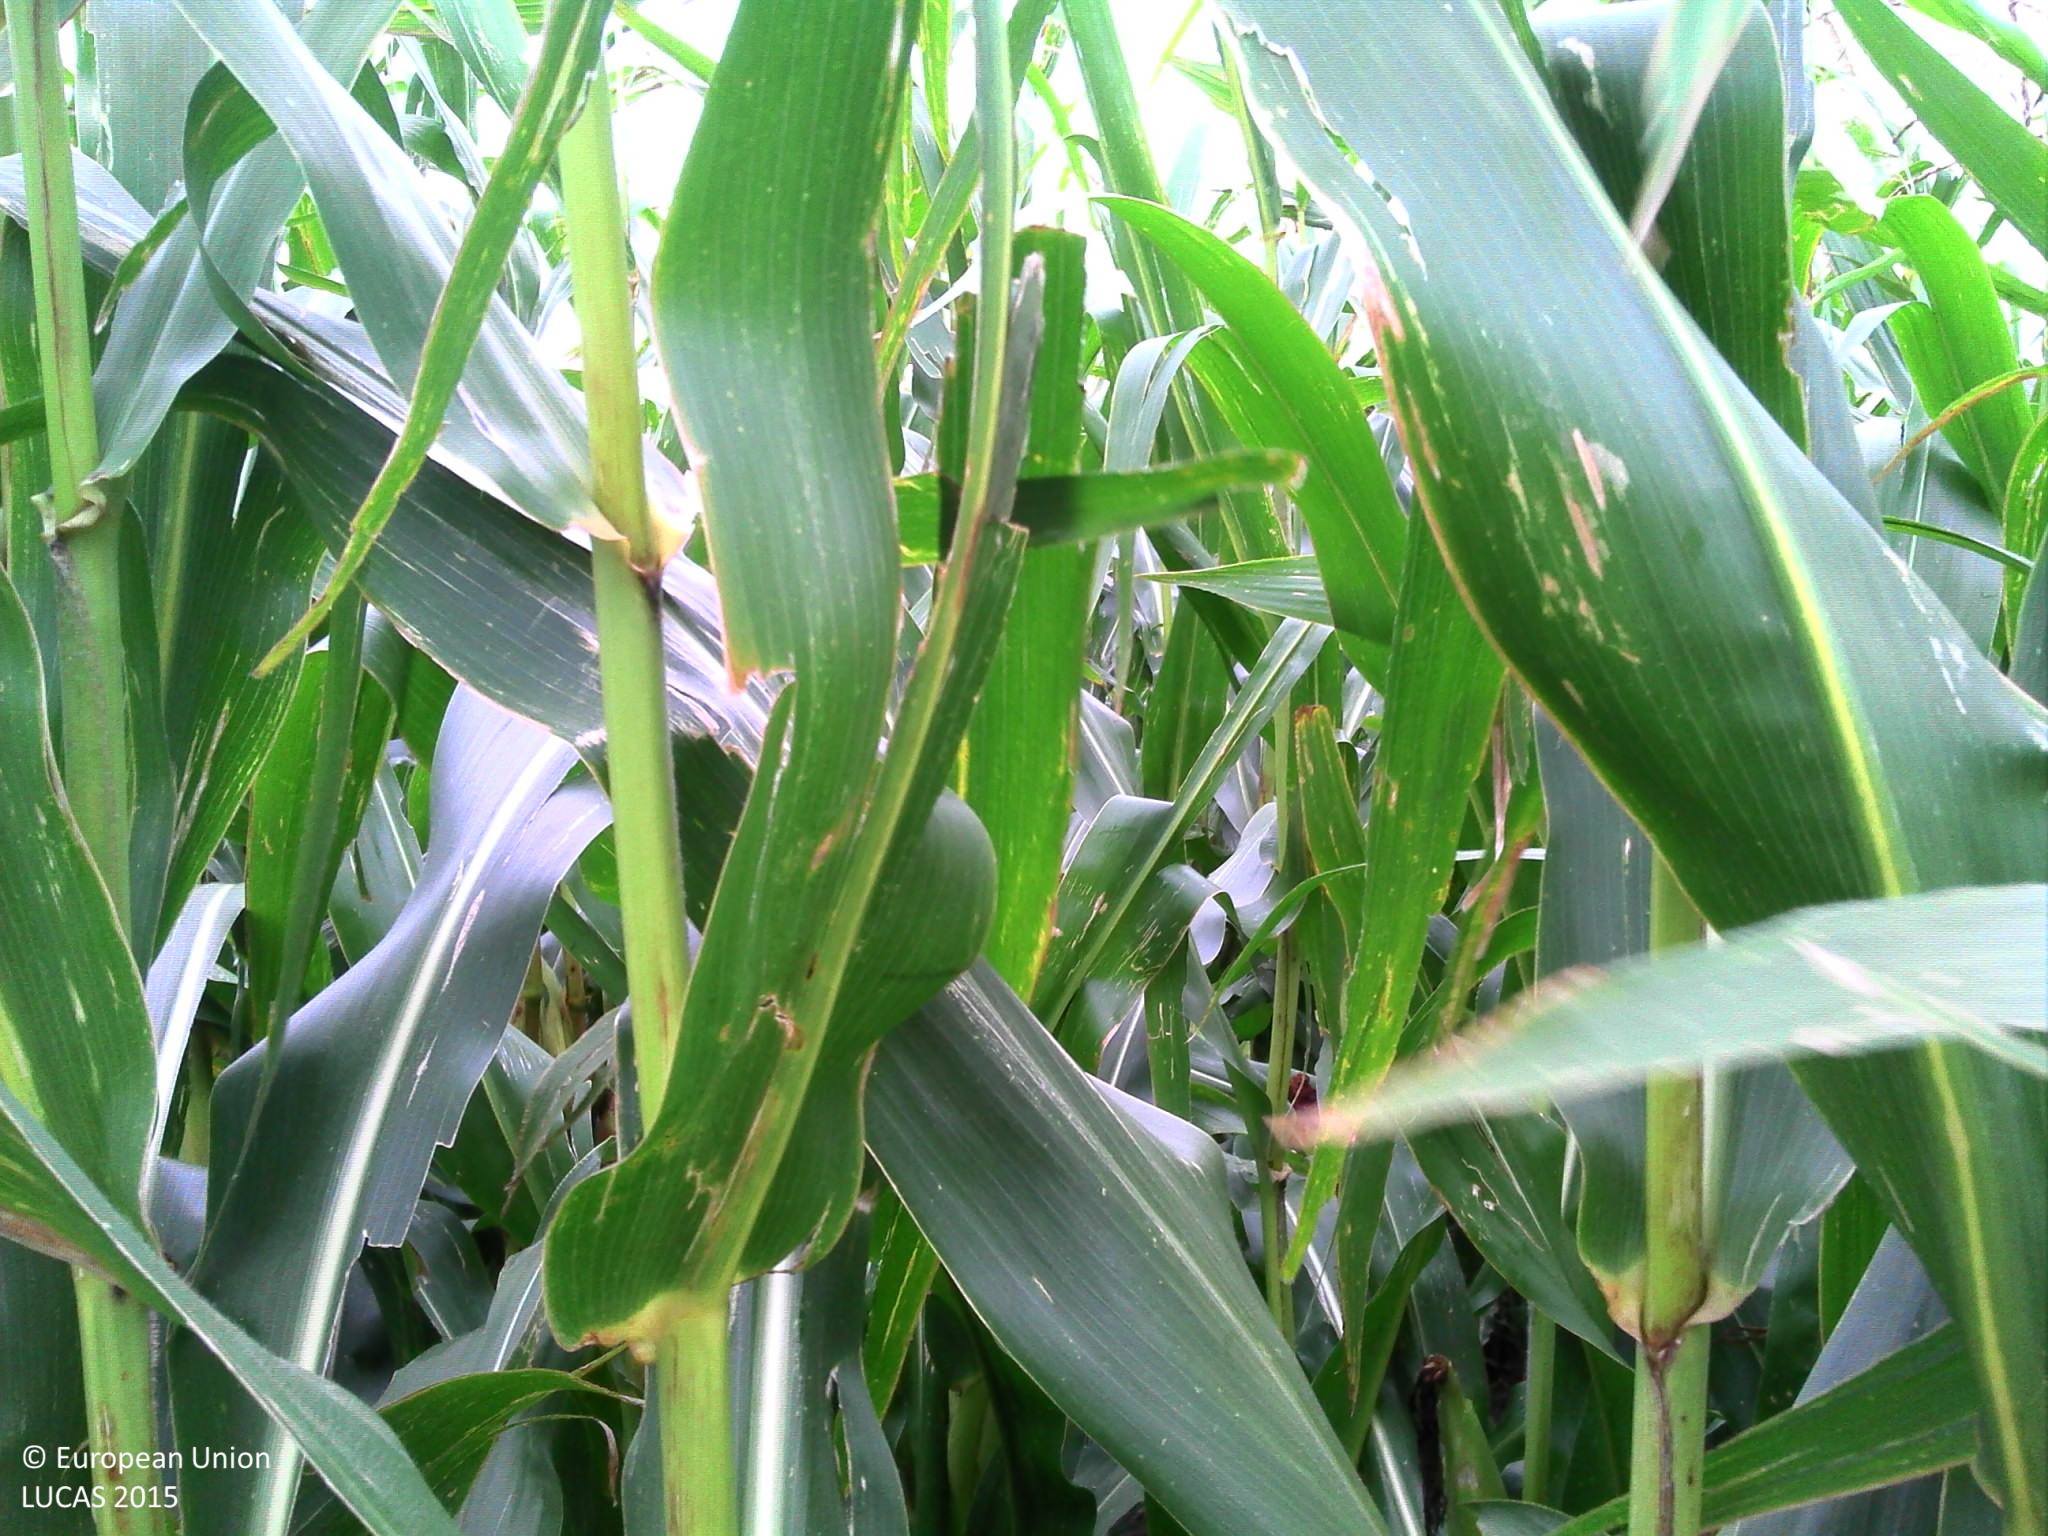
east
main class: Cropland
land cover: Maize
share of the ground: > 75 %
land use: Agriculture (excluding fallow land and kitchen gardens)
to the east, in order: Maize; Ditches and canals; Grass margins; Paved roads, cycling and walking lanes; Grass margins; Ditches and canals; Fences; Grassland without tree/shrub cover
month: September
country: BE
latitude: 51.1405
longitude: 2.9719
